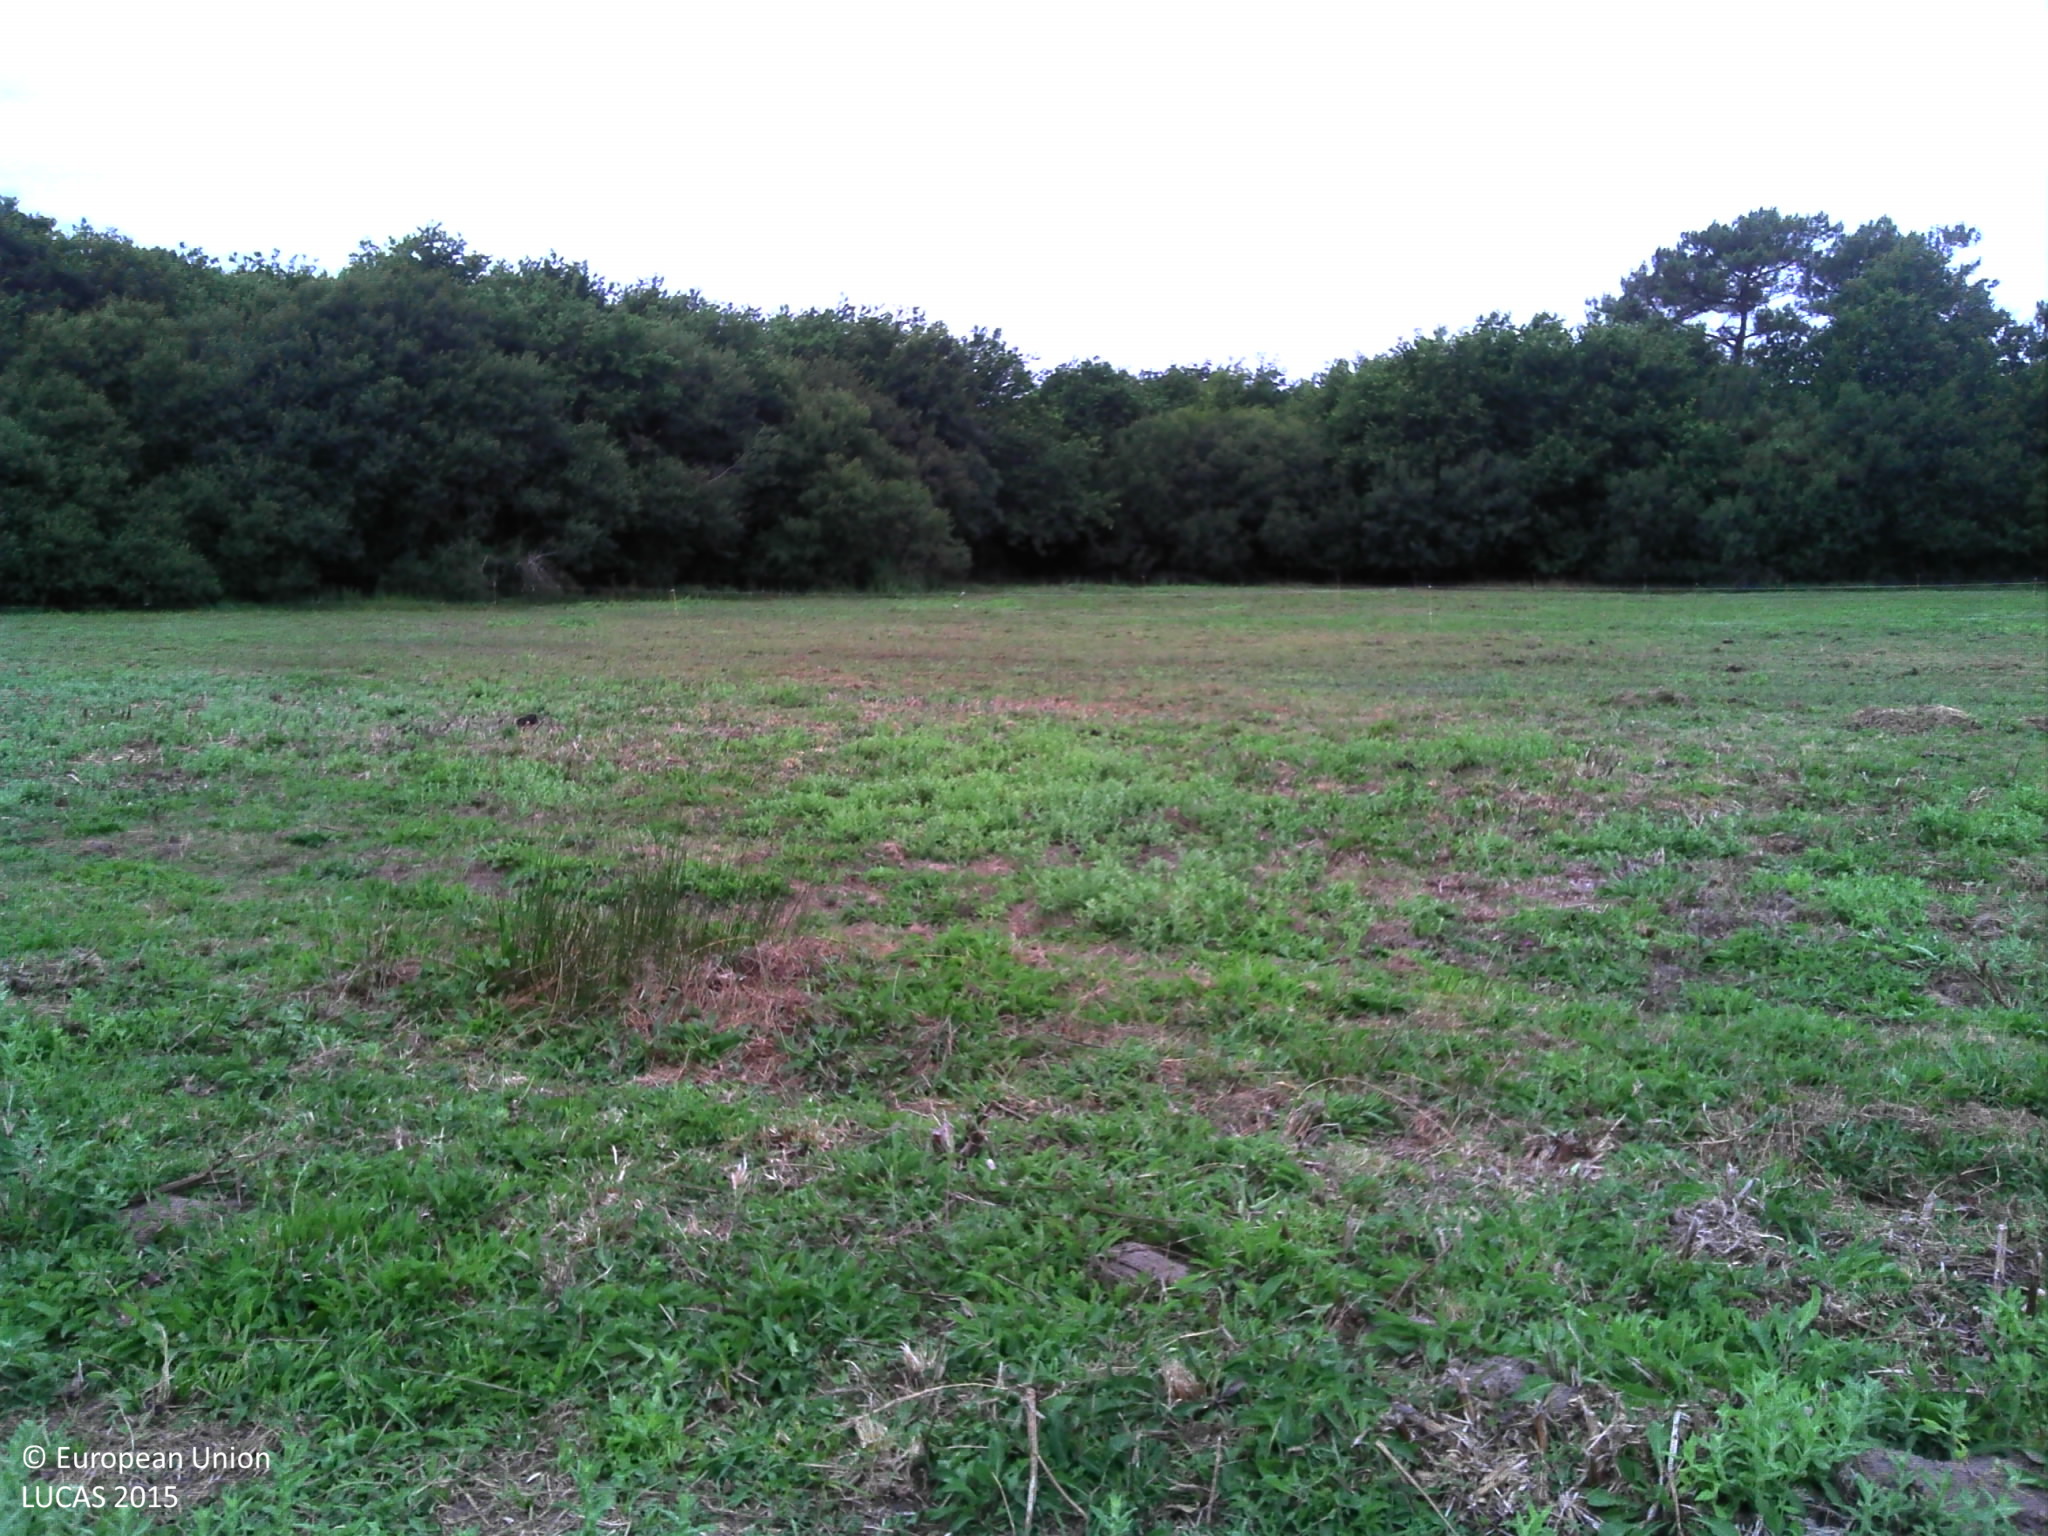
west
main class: Grassland
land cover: Spontaneously vegetated surfaces
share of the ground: > 75 %
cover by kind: herbaceous plants 90 %, unconsolidated bare surface 10 %
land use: Agriculture (excluding fallow land and kitchen gardens)
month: July
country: FR
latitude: 47.6787
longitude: -3.2170
